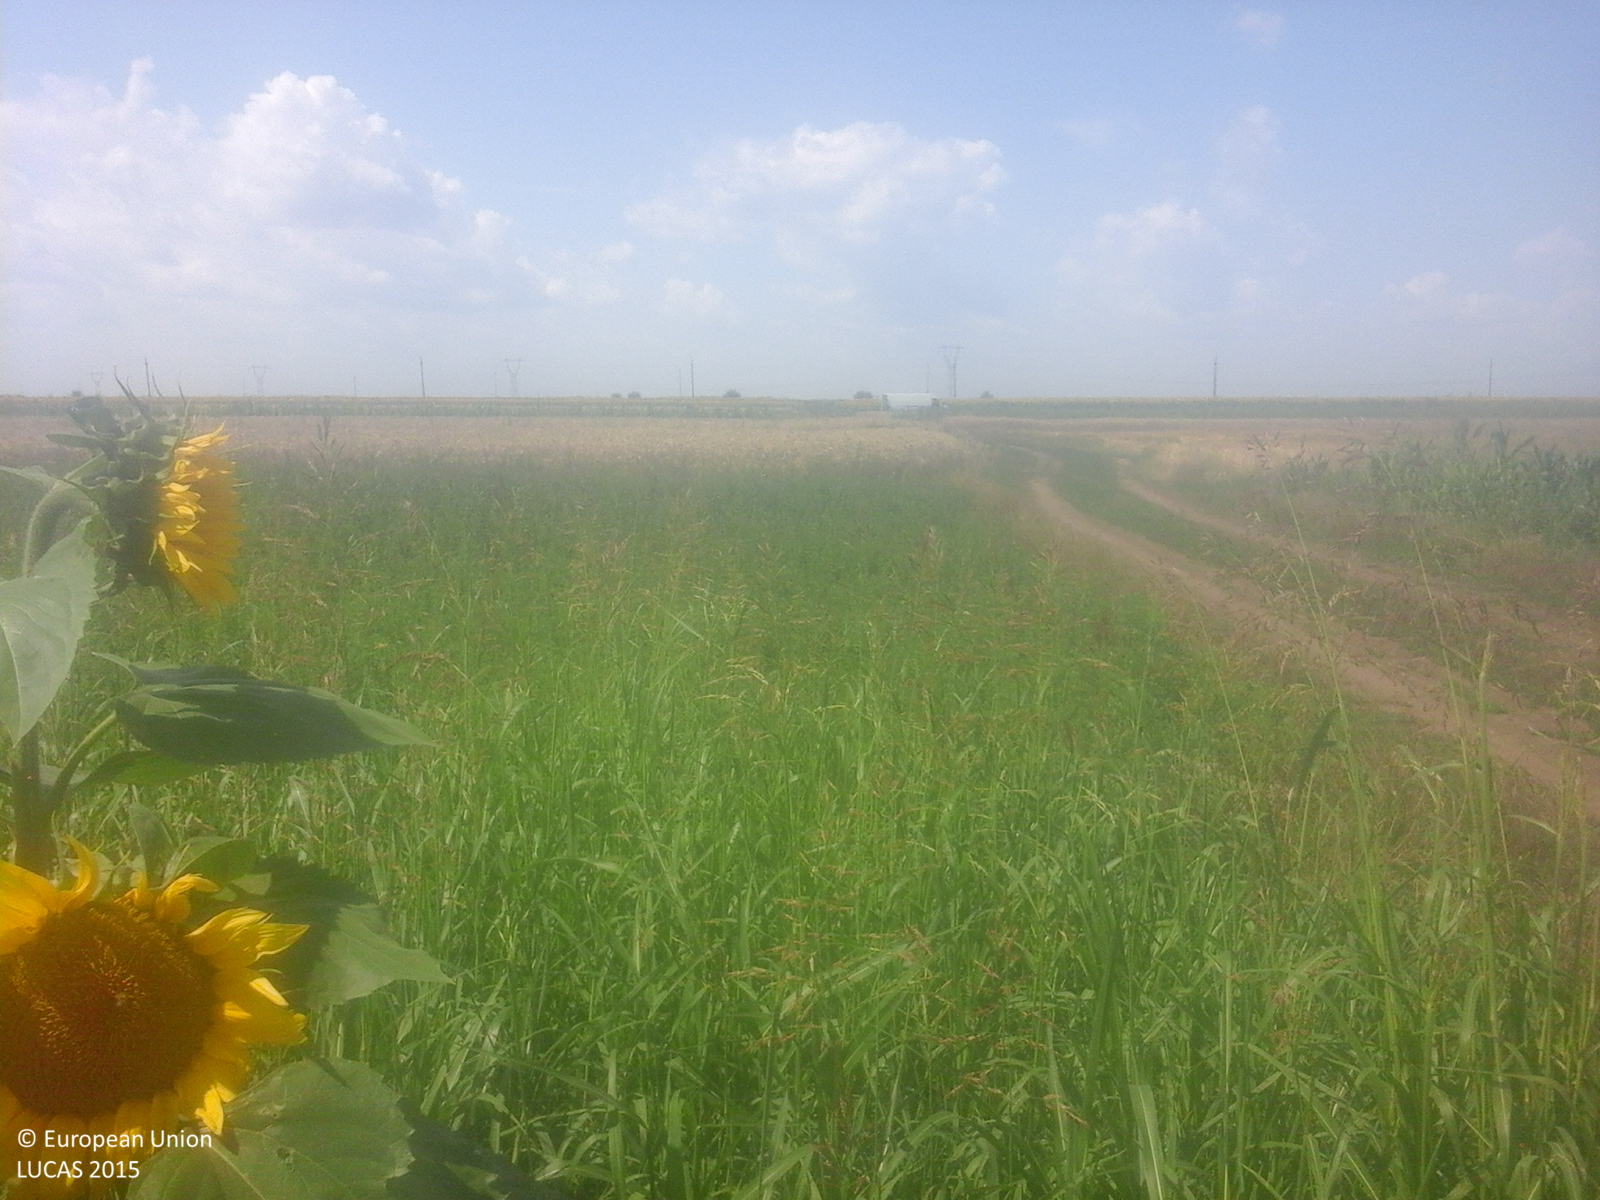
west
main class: Cropland
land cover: Sunflower
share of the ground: > 75 %
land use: Agriculture (excluding fallow land and kitchen gardens)
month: July
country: RO
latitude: 43.8237
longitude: 24.6022
